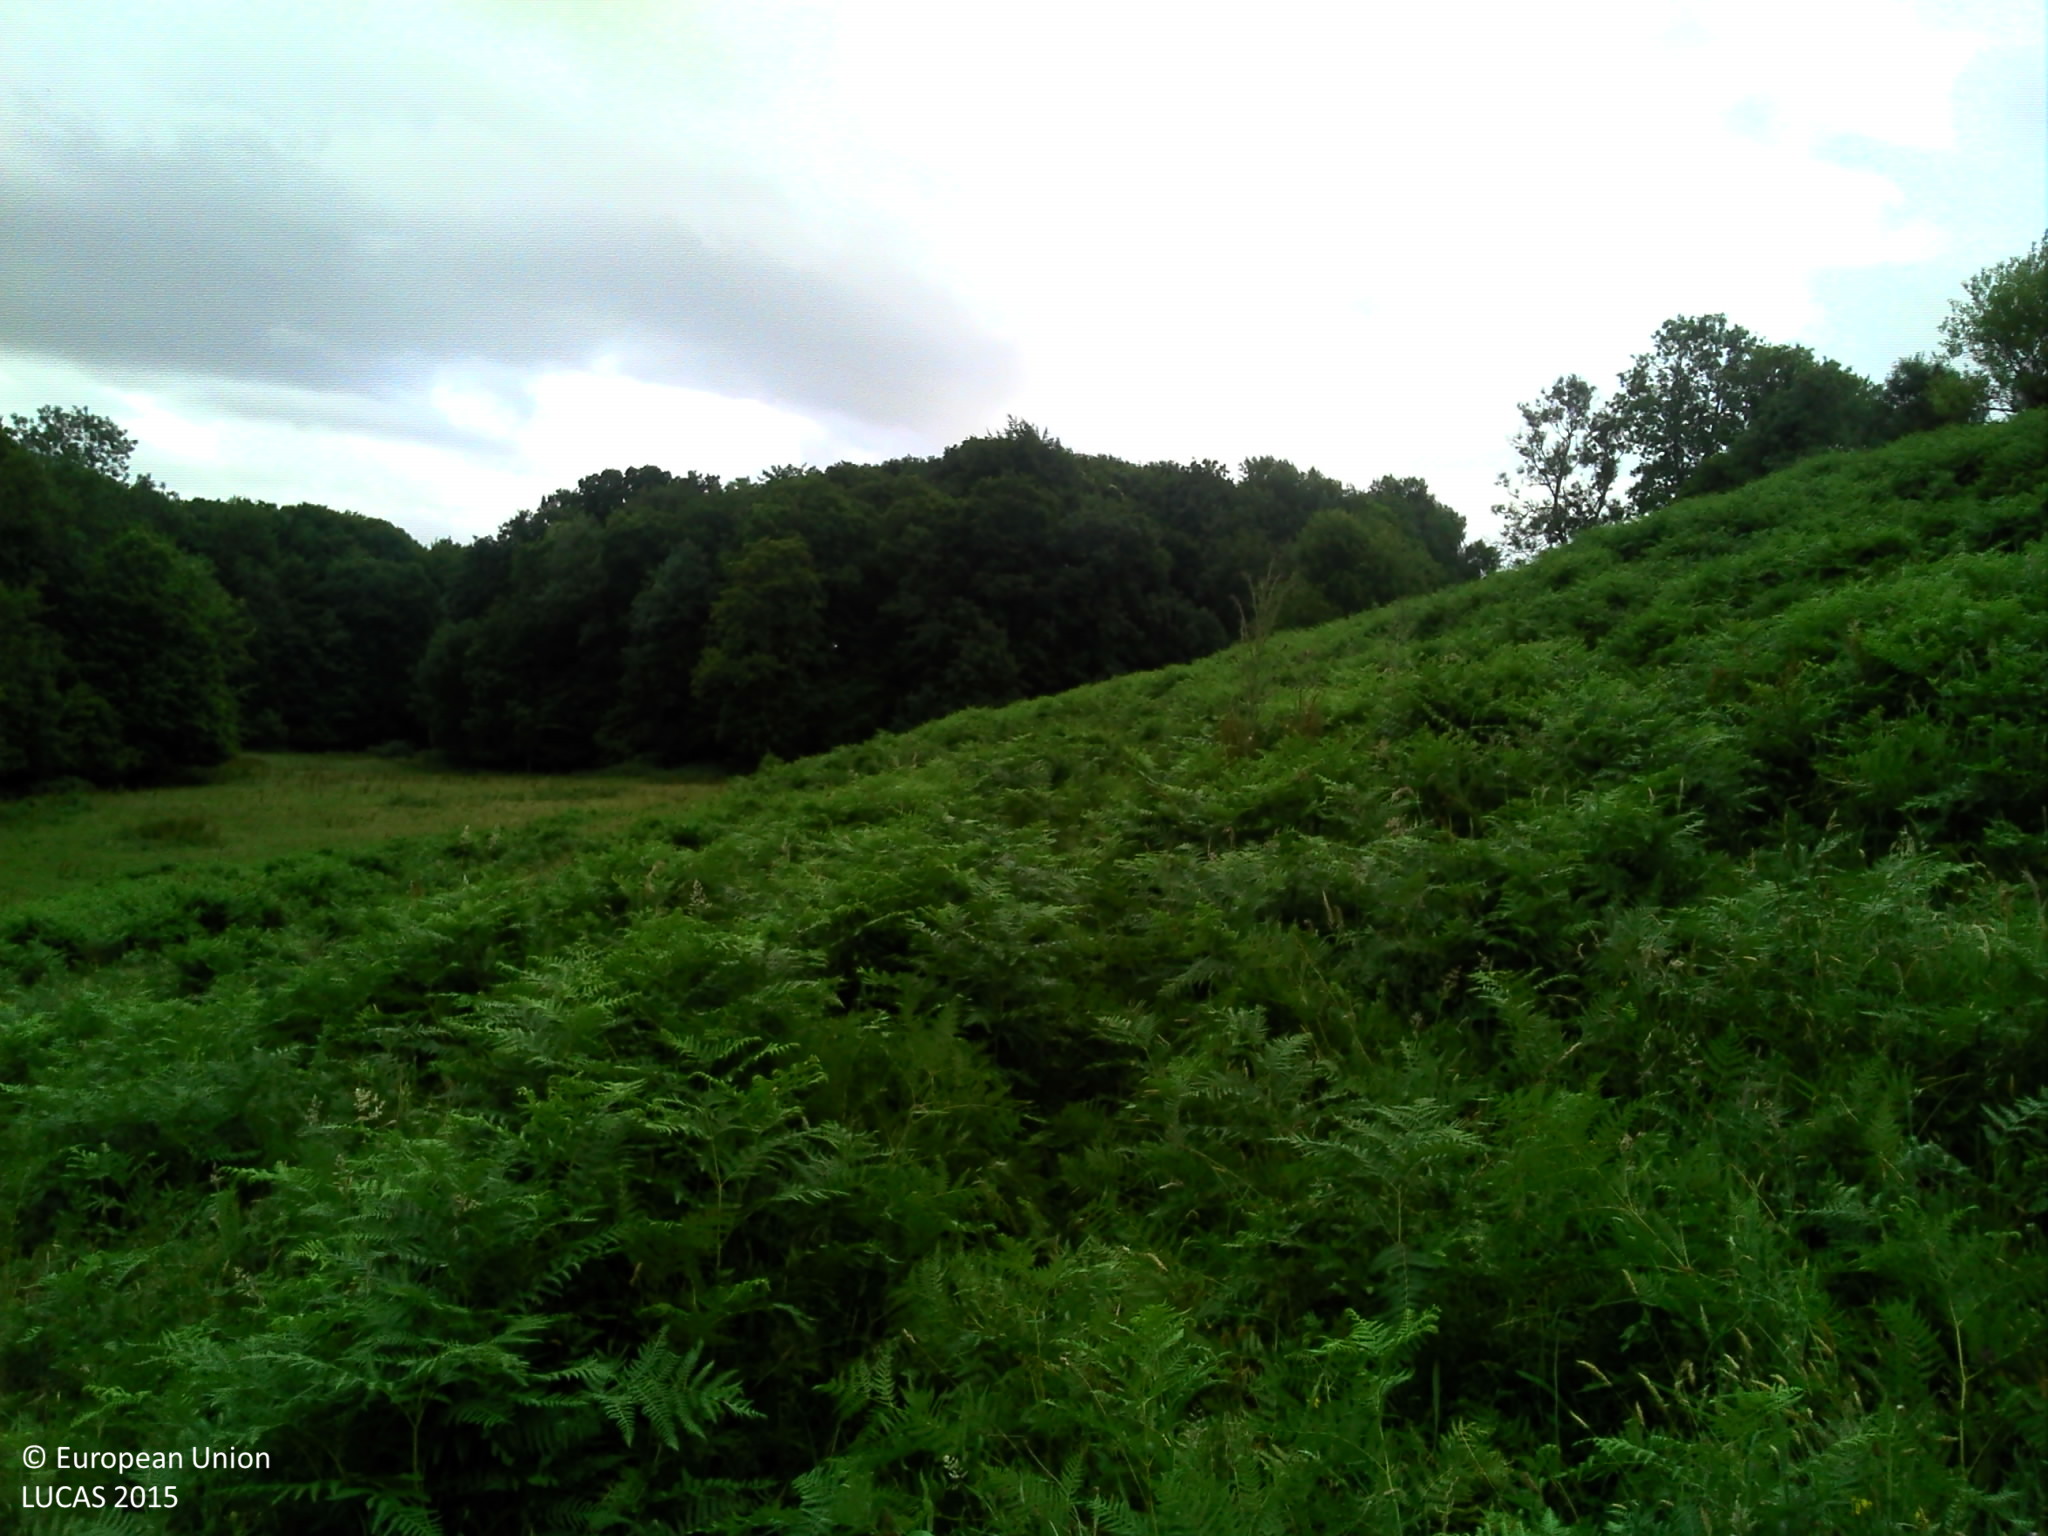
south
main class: Grassland
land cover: Spontaneously vegetated surfaces
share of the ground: > 75 %
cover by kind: herbaceous plants 100 %
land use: Agriculture (excluding fallow land and kitchen gardens)
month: July
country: FR
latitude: 49.3371
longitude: 0.3246
